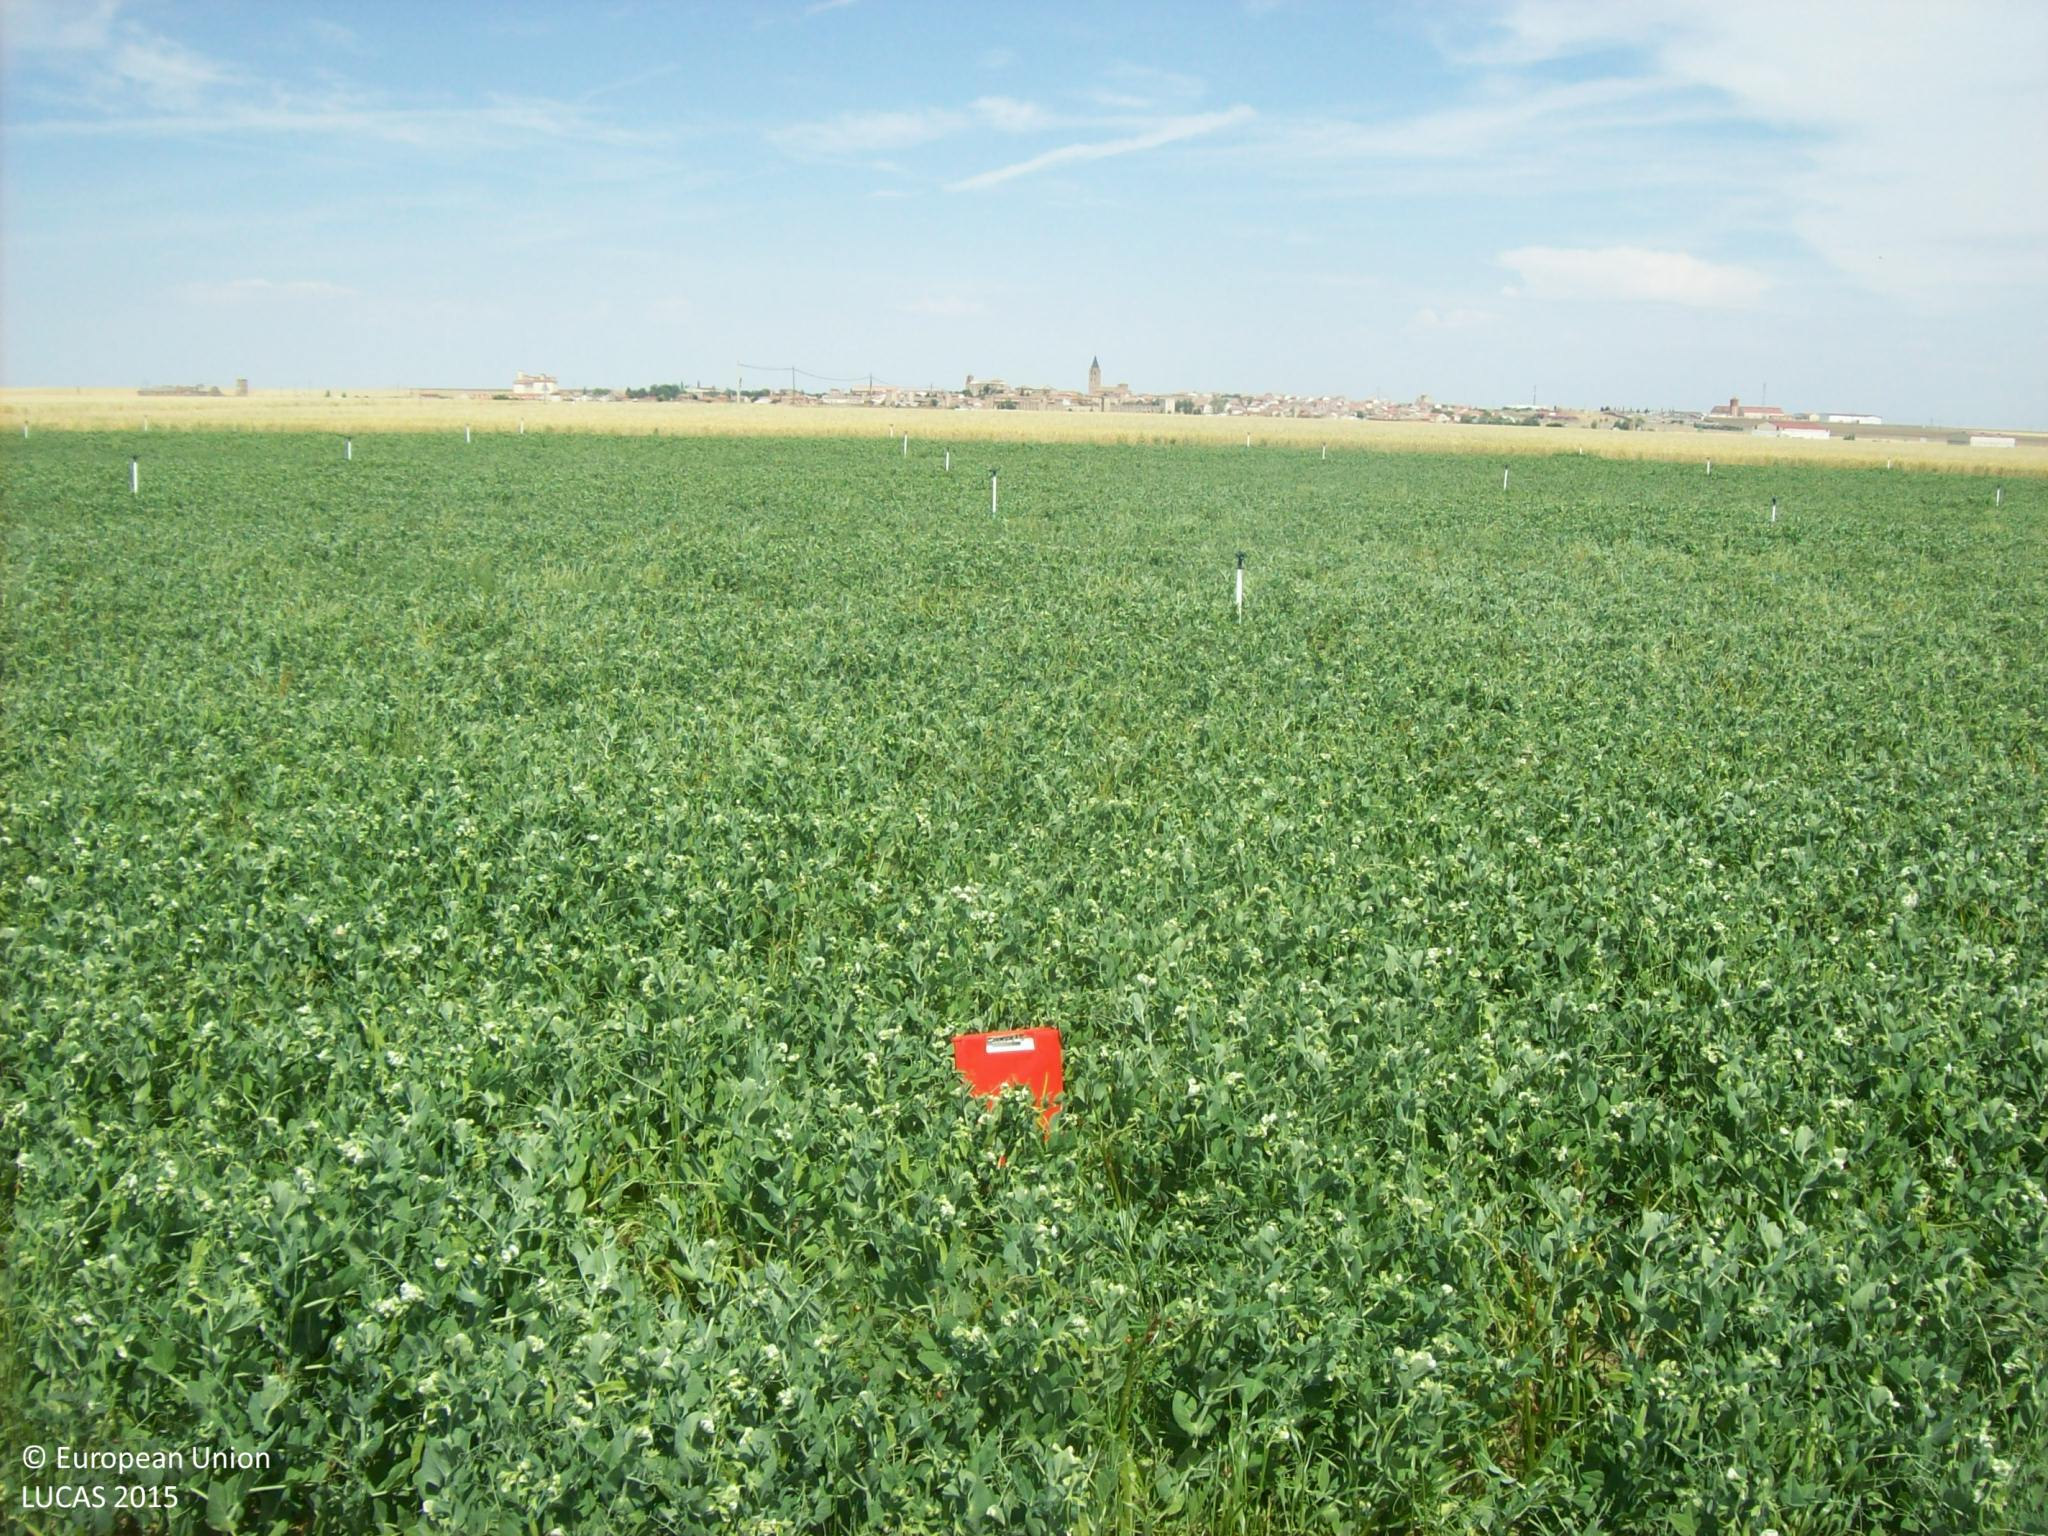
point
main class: Cropland
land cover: Dry pulses
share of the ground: > 75 %
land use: Agriculture (excluding fallow land and kitchen gardens)
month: June
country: ES
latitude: 41.0743
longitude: -4.9790
